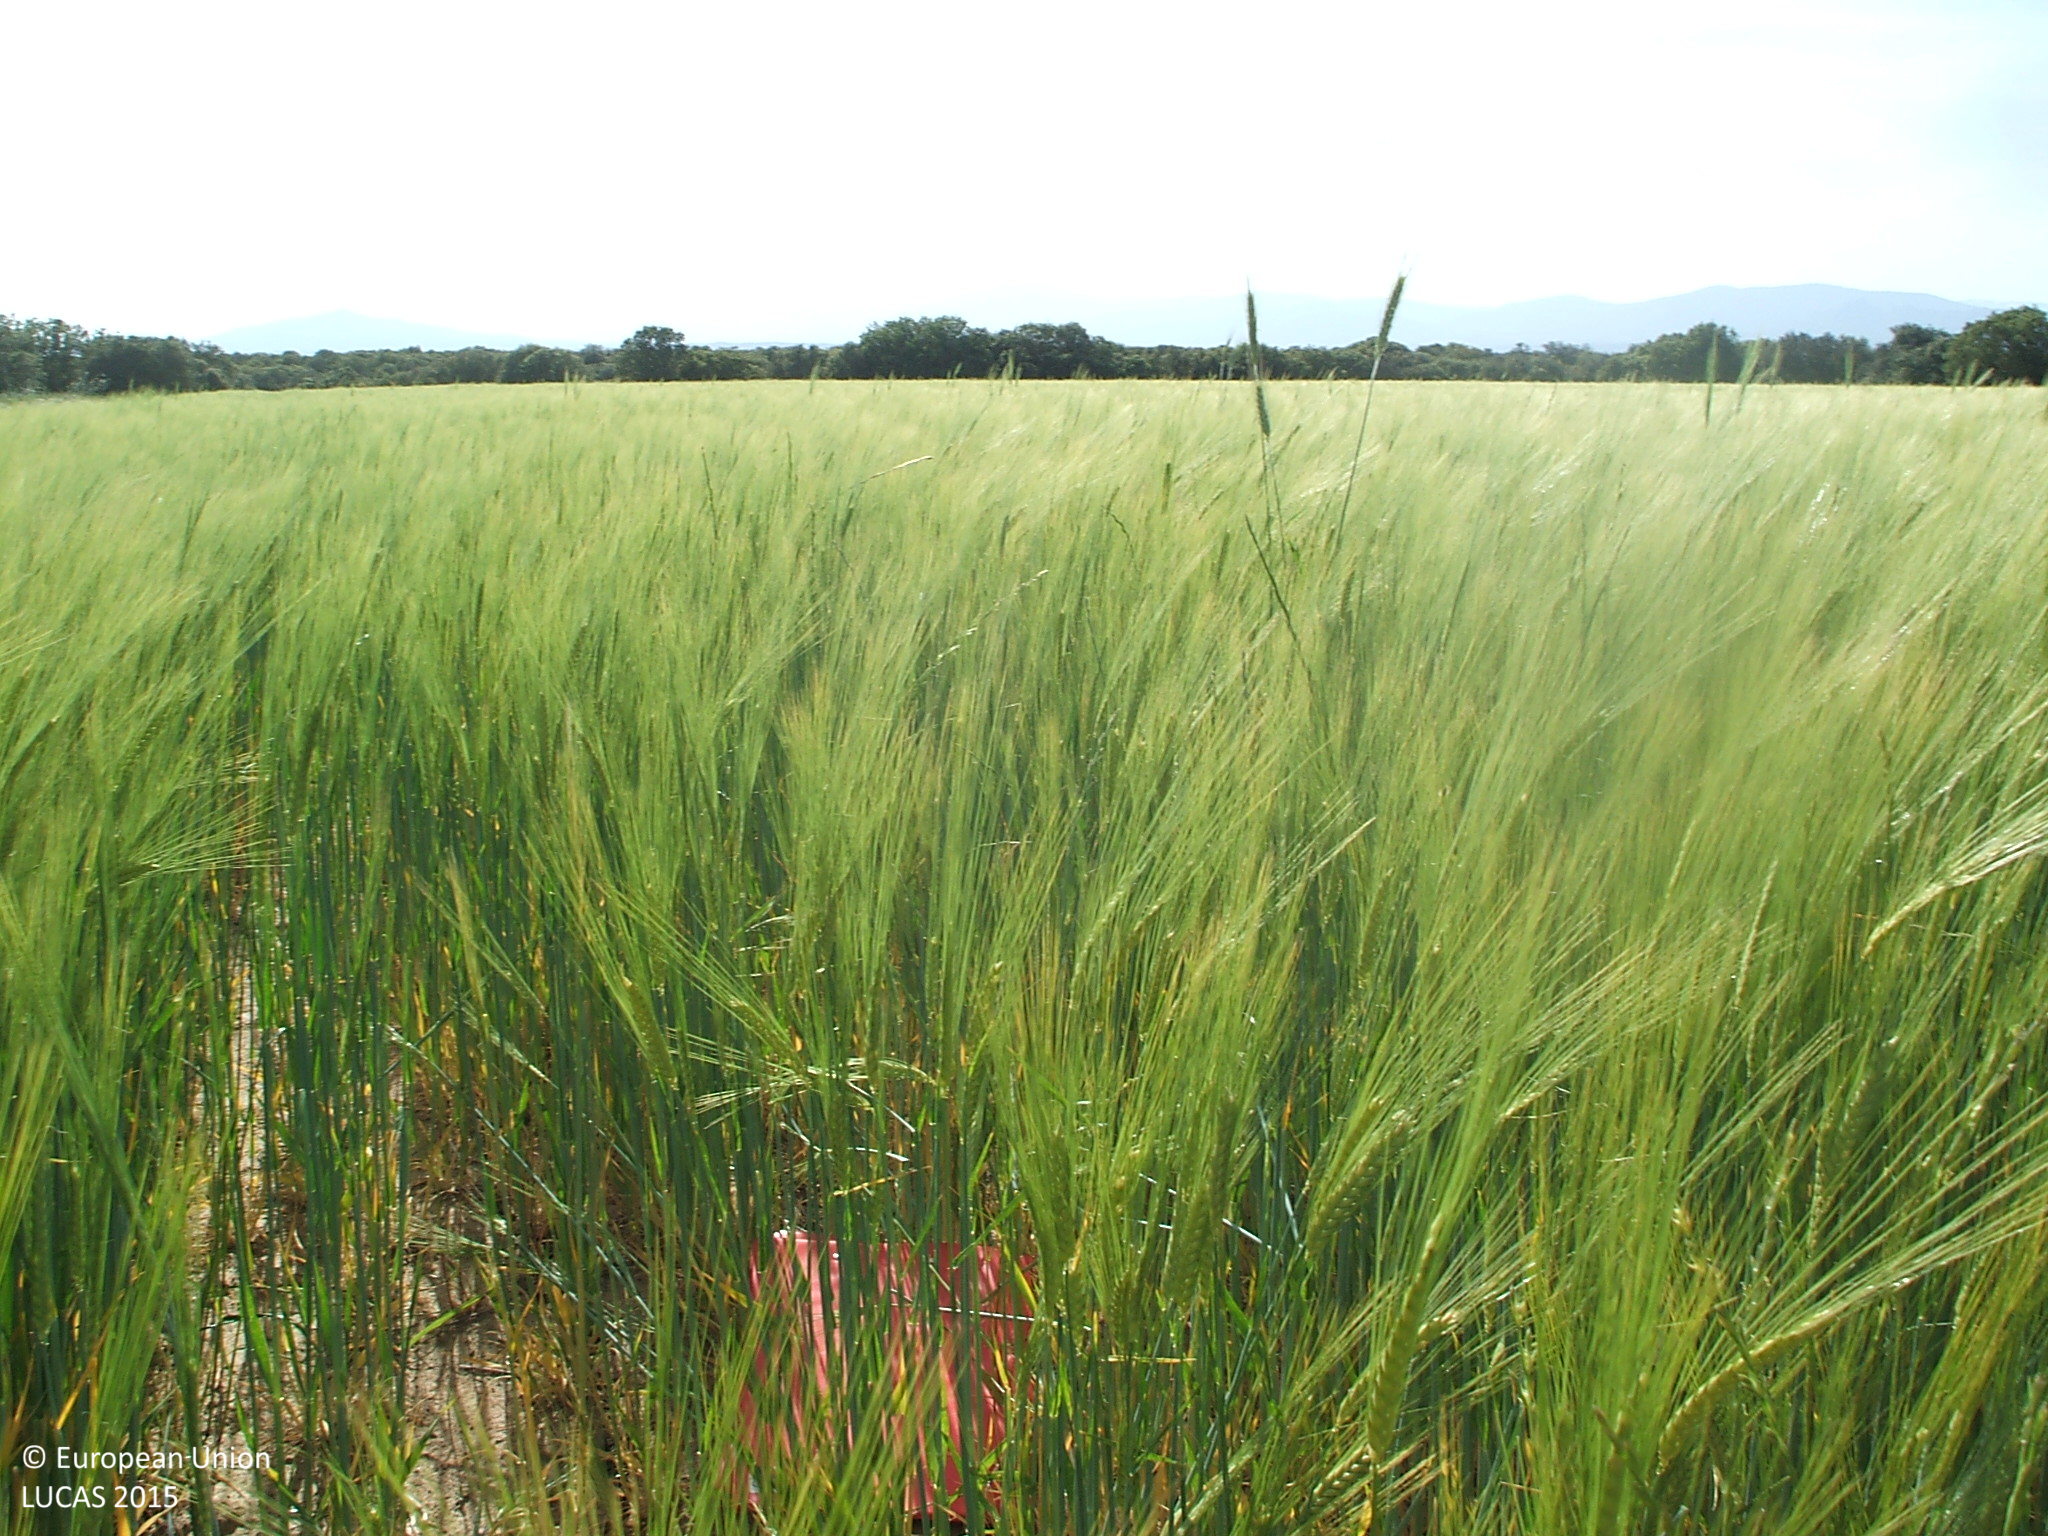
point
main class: Cropland
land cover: Barley
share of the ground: > 75 %
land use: Agriculture (excluding fallow land and kitchen gardens)
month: May
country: ES
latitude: 40.7728
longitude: -3.3905
